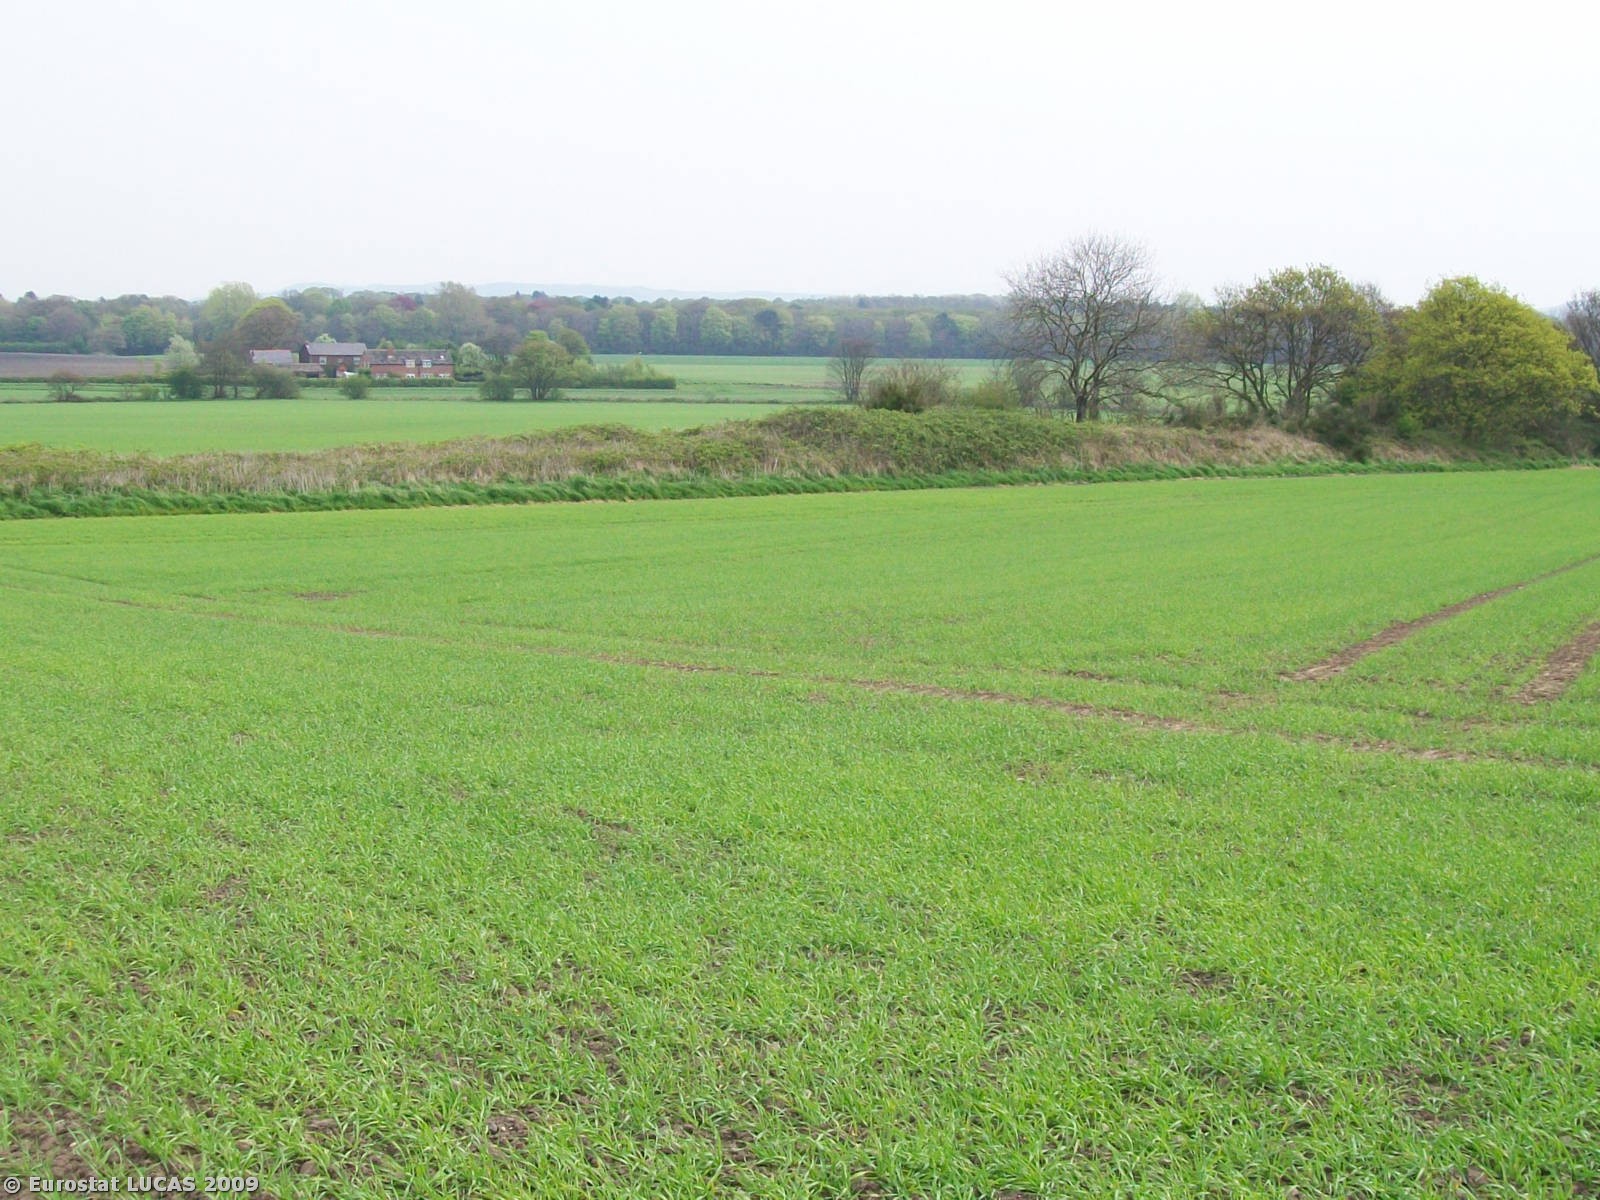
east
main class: Cropland
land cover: Barley
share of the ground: 50 - 75 %
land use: Agriculture (excluding fallow land and kitchen gardens)
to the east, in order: Barley; Abandoned hedges; Barley
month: April
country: GB
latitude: 53.5687
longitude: -2.8612
